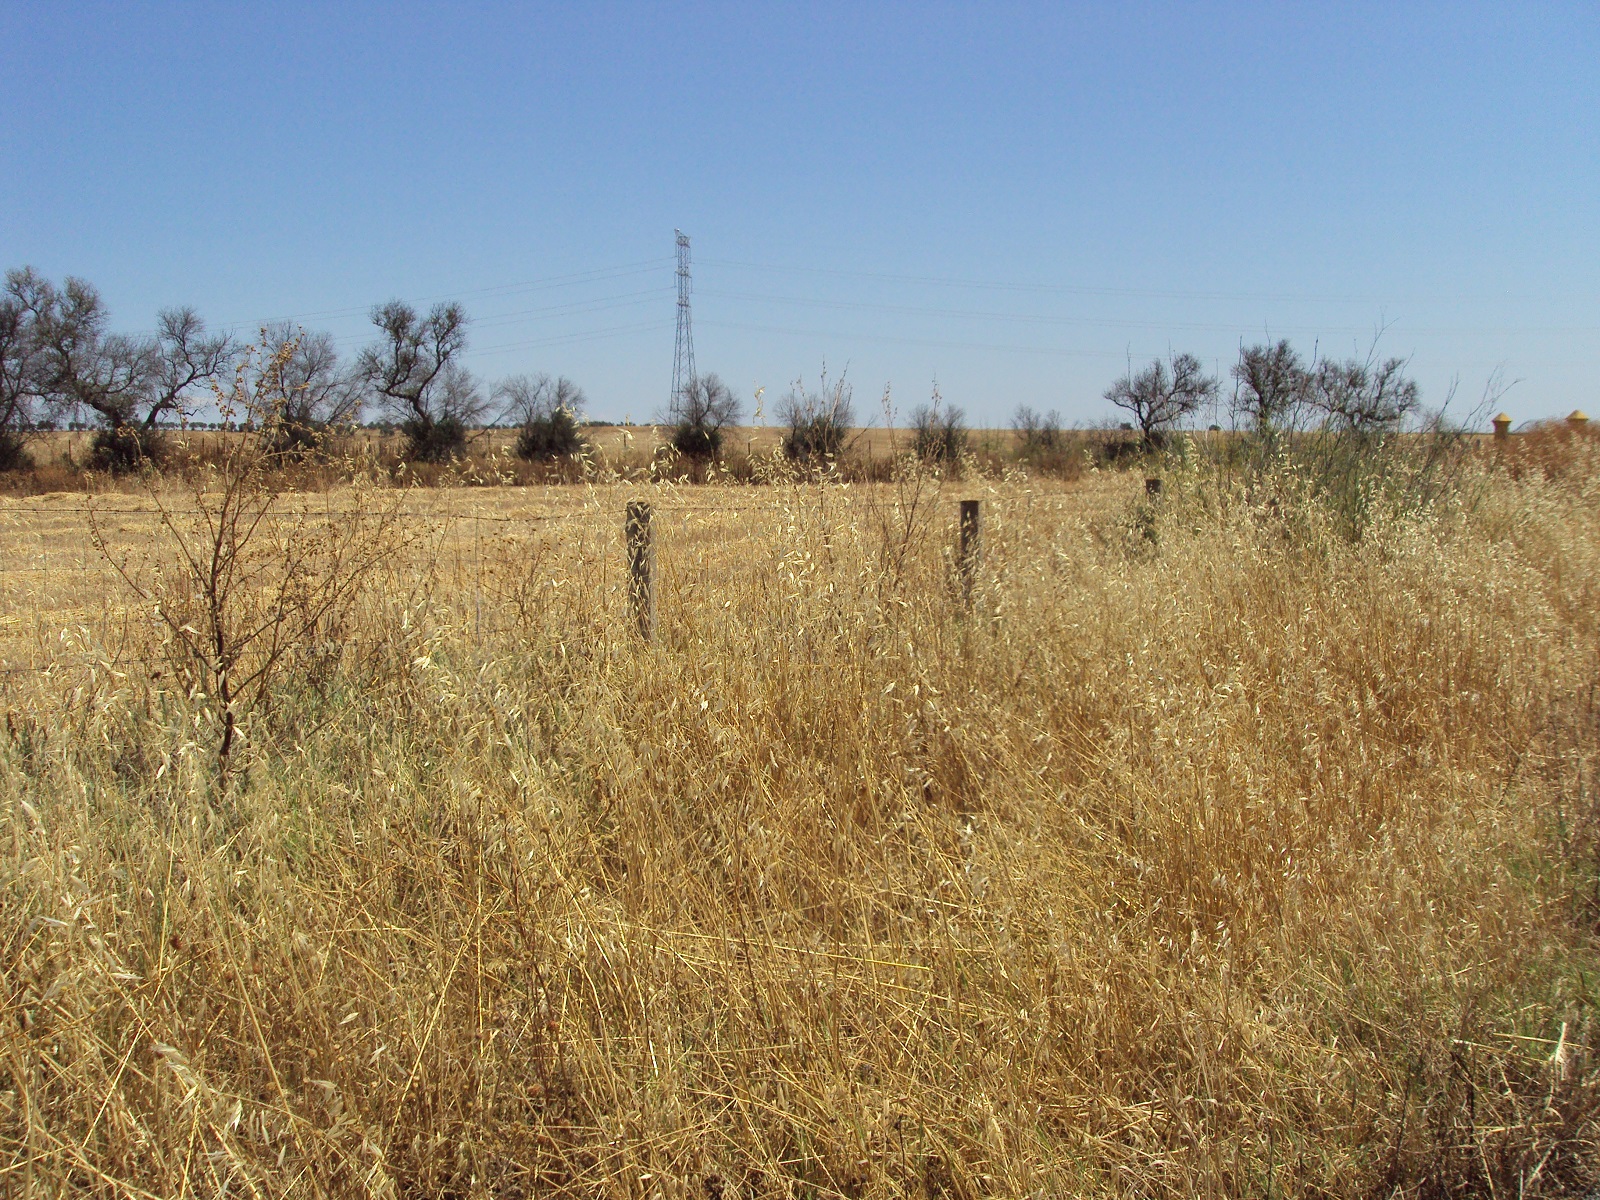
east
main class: Cropland
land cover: Durum wheat
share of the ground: > 75 %
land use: Agriculture (excluding fallow land and kitchen gardens)
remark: Harvested field
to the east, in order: Durum wheat; Tracks; Lines of trees; Fences; Grass margins; Durum wheat
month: June
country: ES
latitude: 37.3864
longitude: -6.9025
